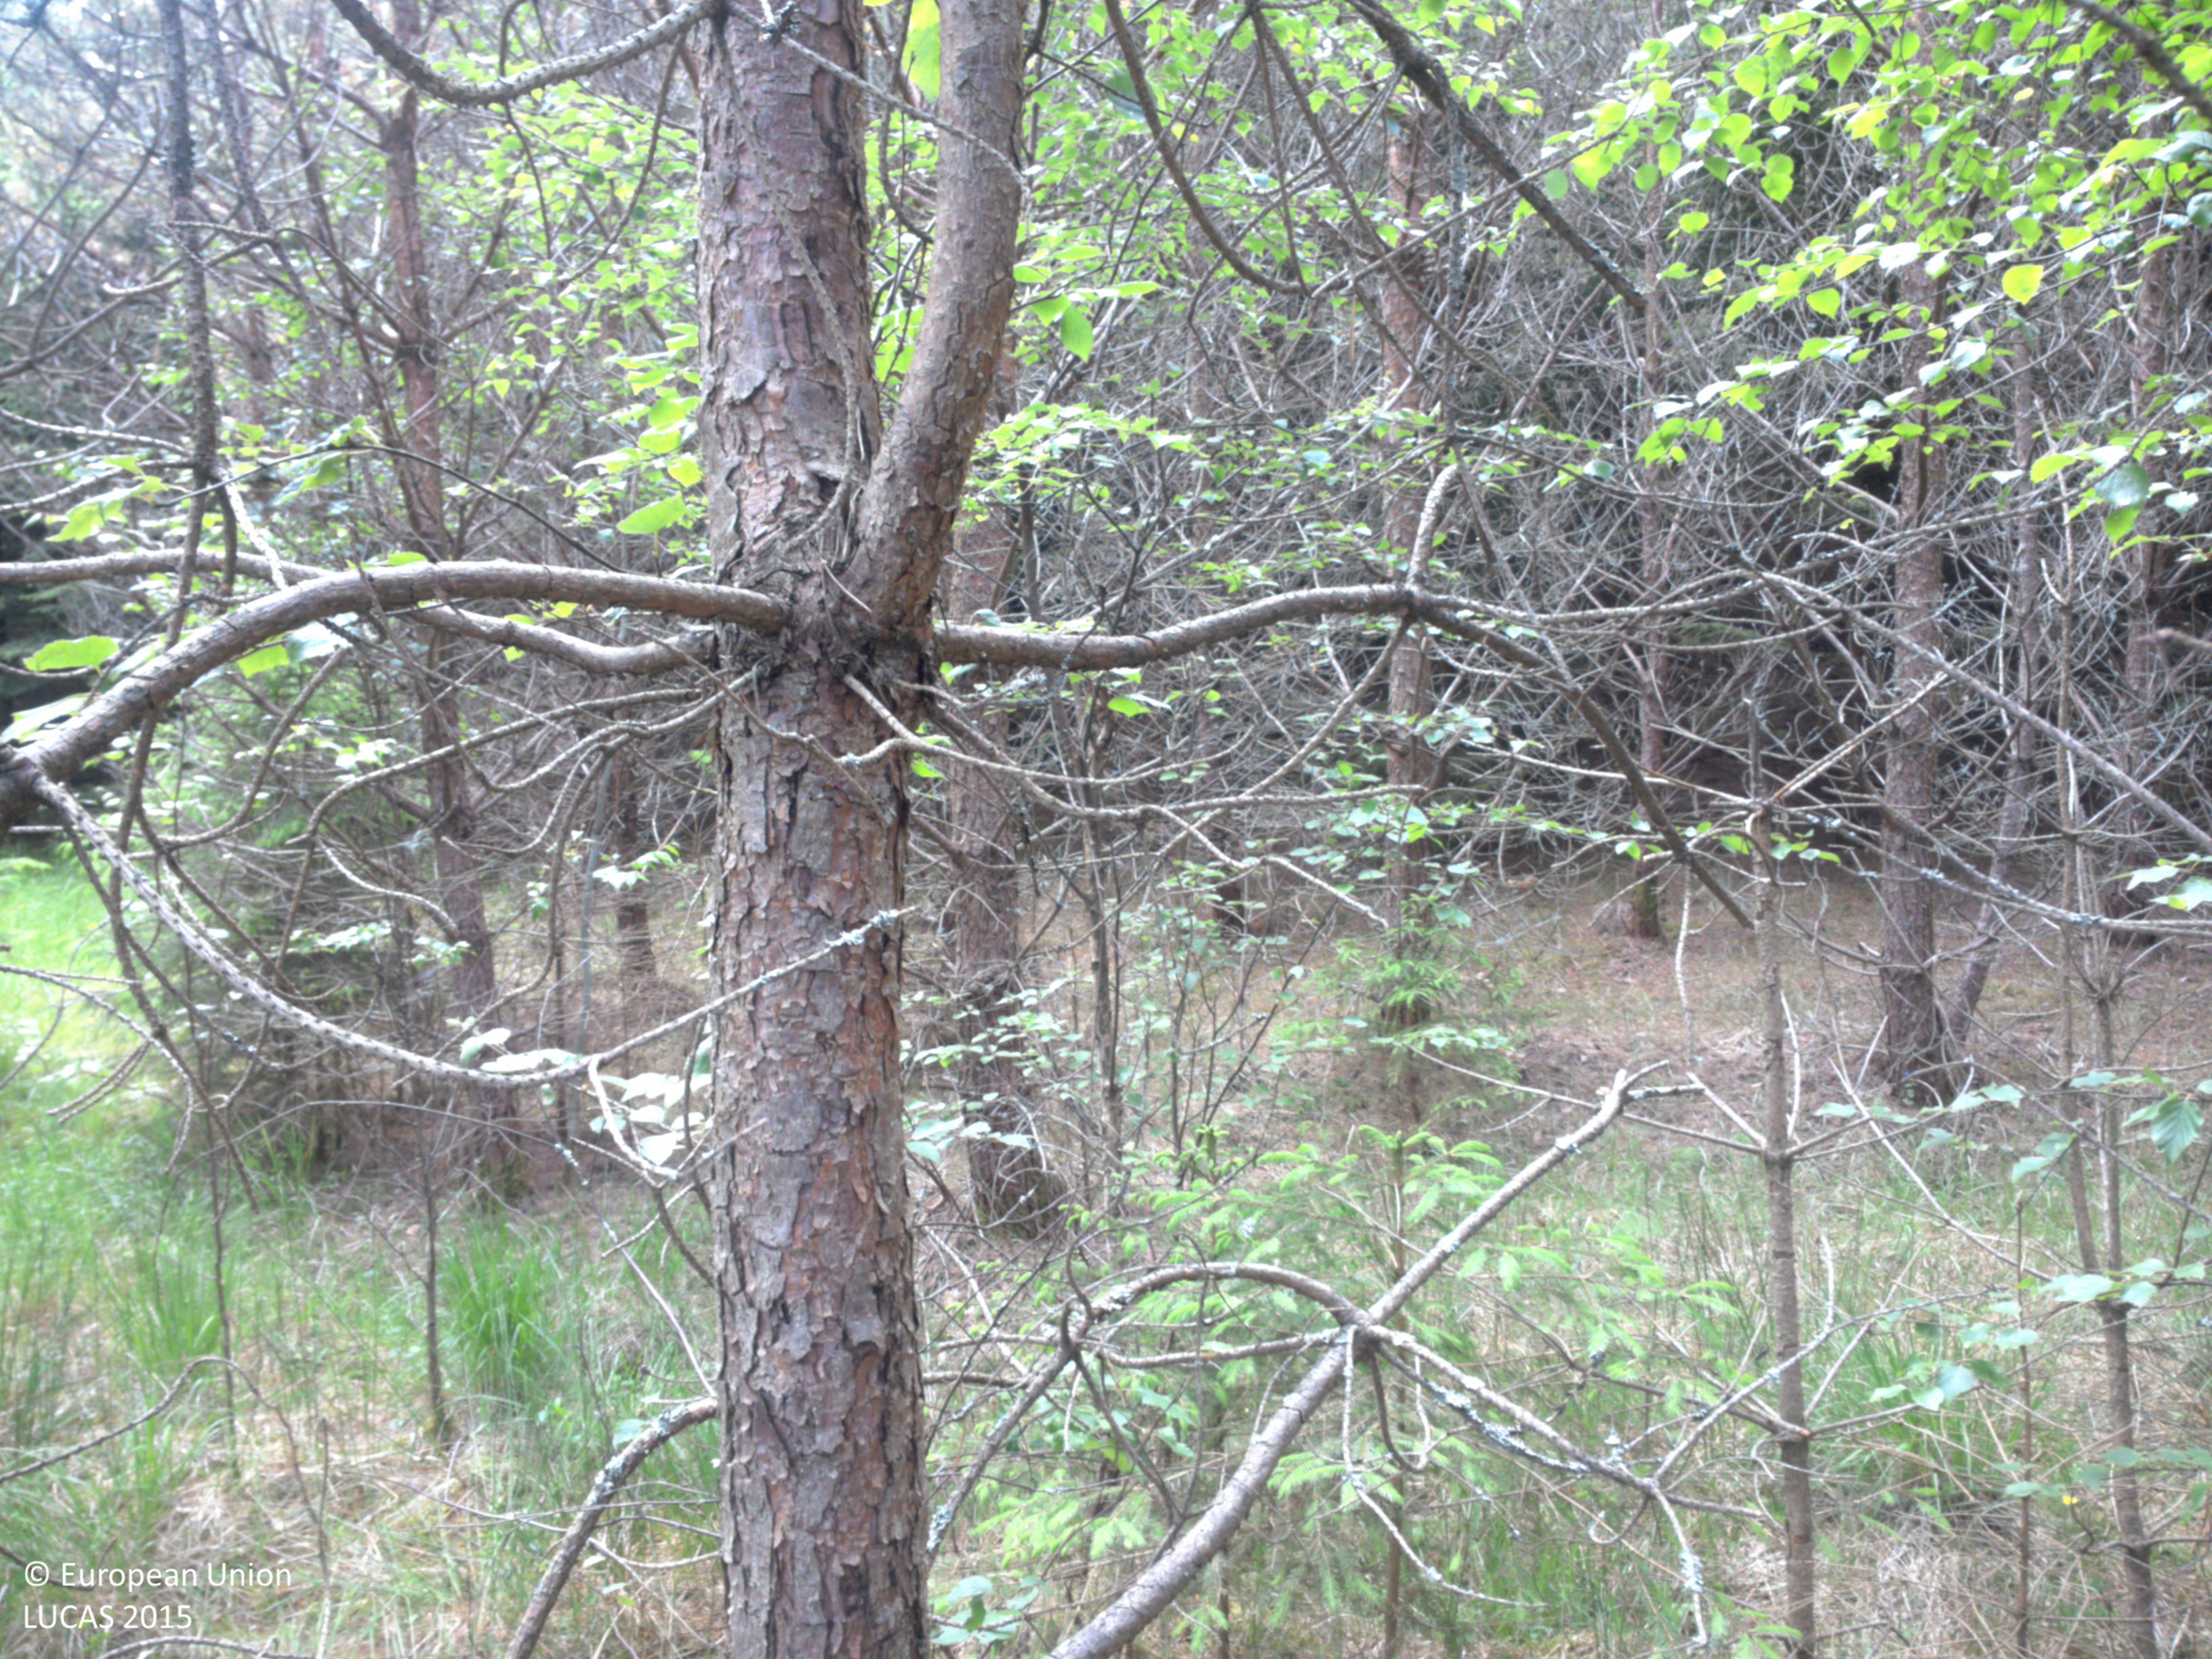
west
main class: Woodland
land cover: Pine dominated coniferous woodland
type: boreal forest
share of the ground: > 75 %
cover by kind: coniferous forest trees 80 %, herbaceous plants 10 %, lichens and mosses 10 %
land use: Forestry
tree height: < 5 m
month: June
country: SE
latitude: 58.8216
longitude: 11.6069
